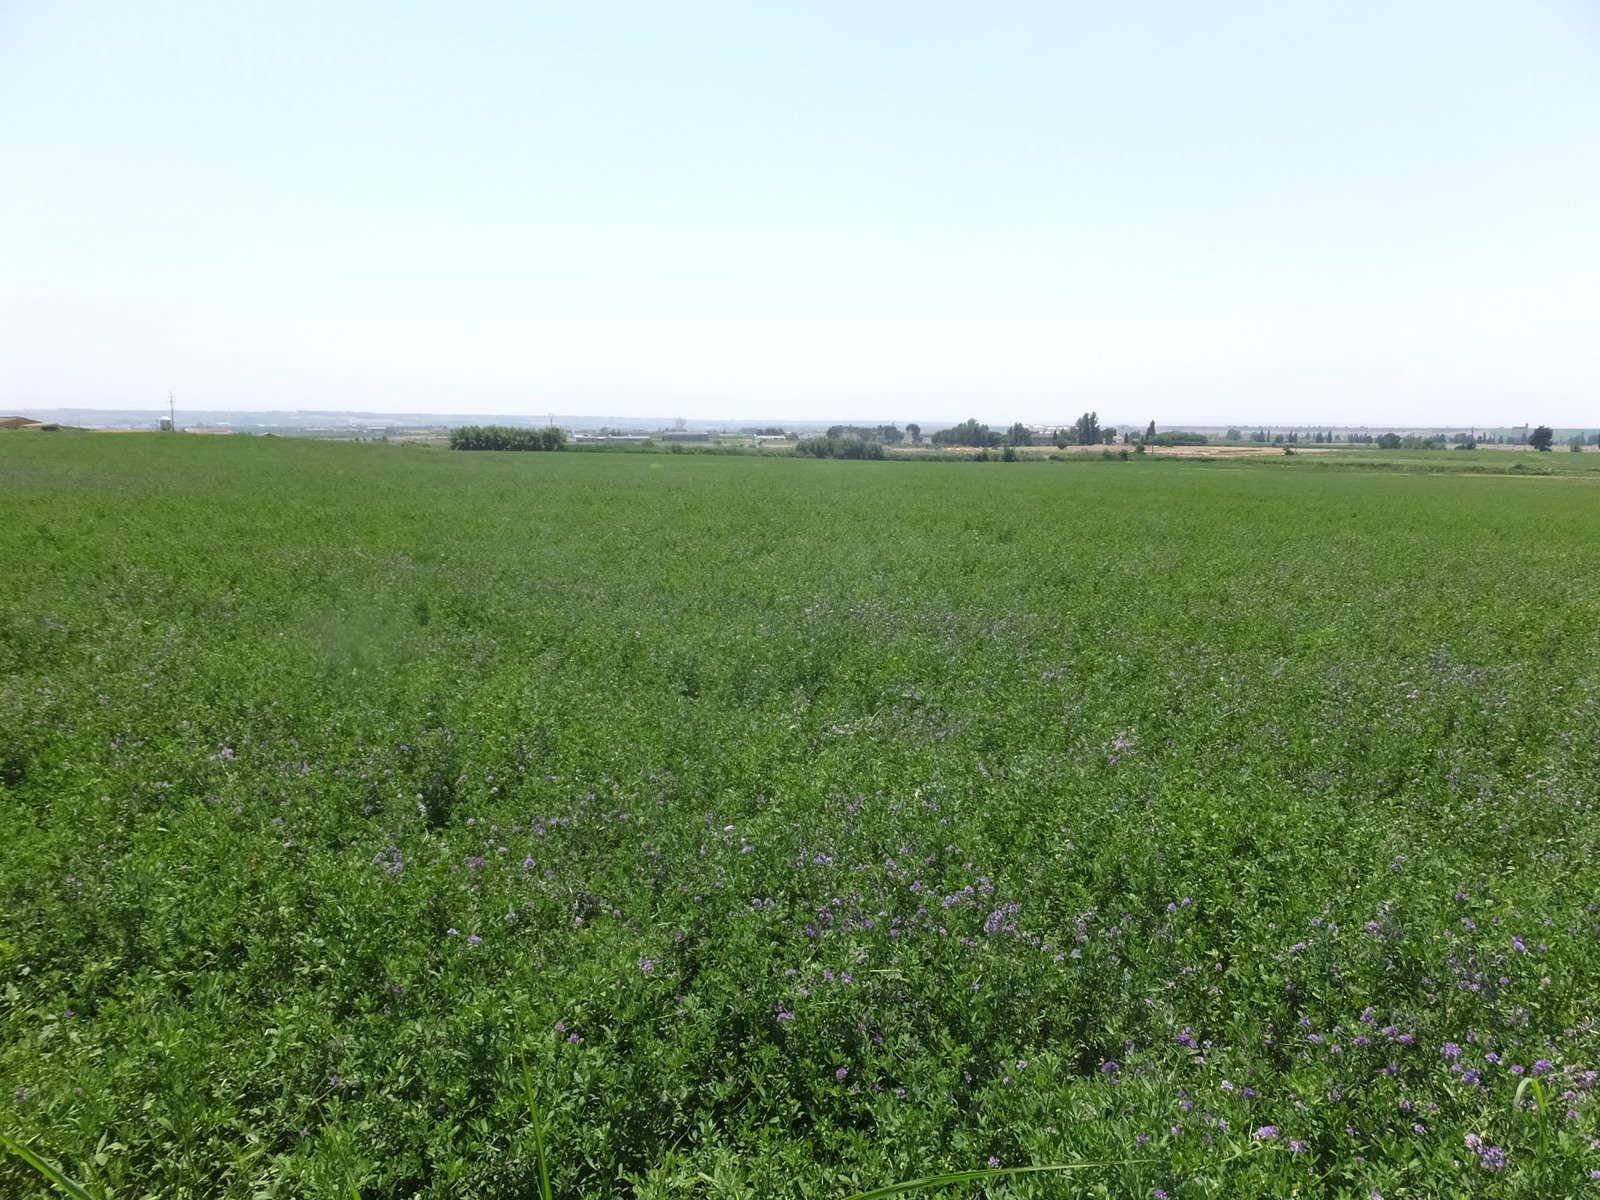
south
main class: Cropland
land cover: Lucerne
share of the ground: > 75 %
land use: Agriculture (excluding fallow land and kitchen gardens)
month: June
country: ES
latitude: 41.7965
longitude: 0.3936
